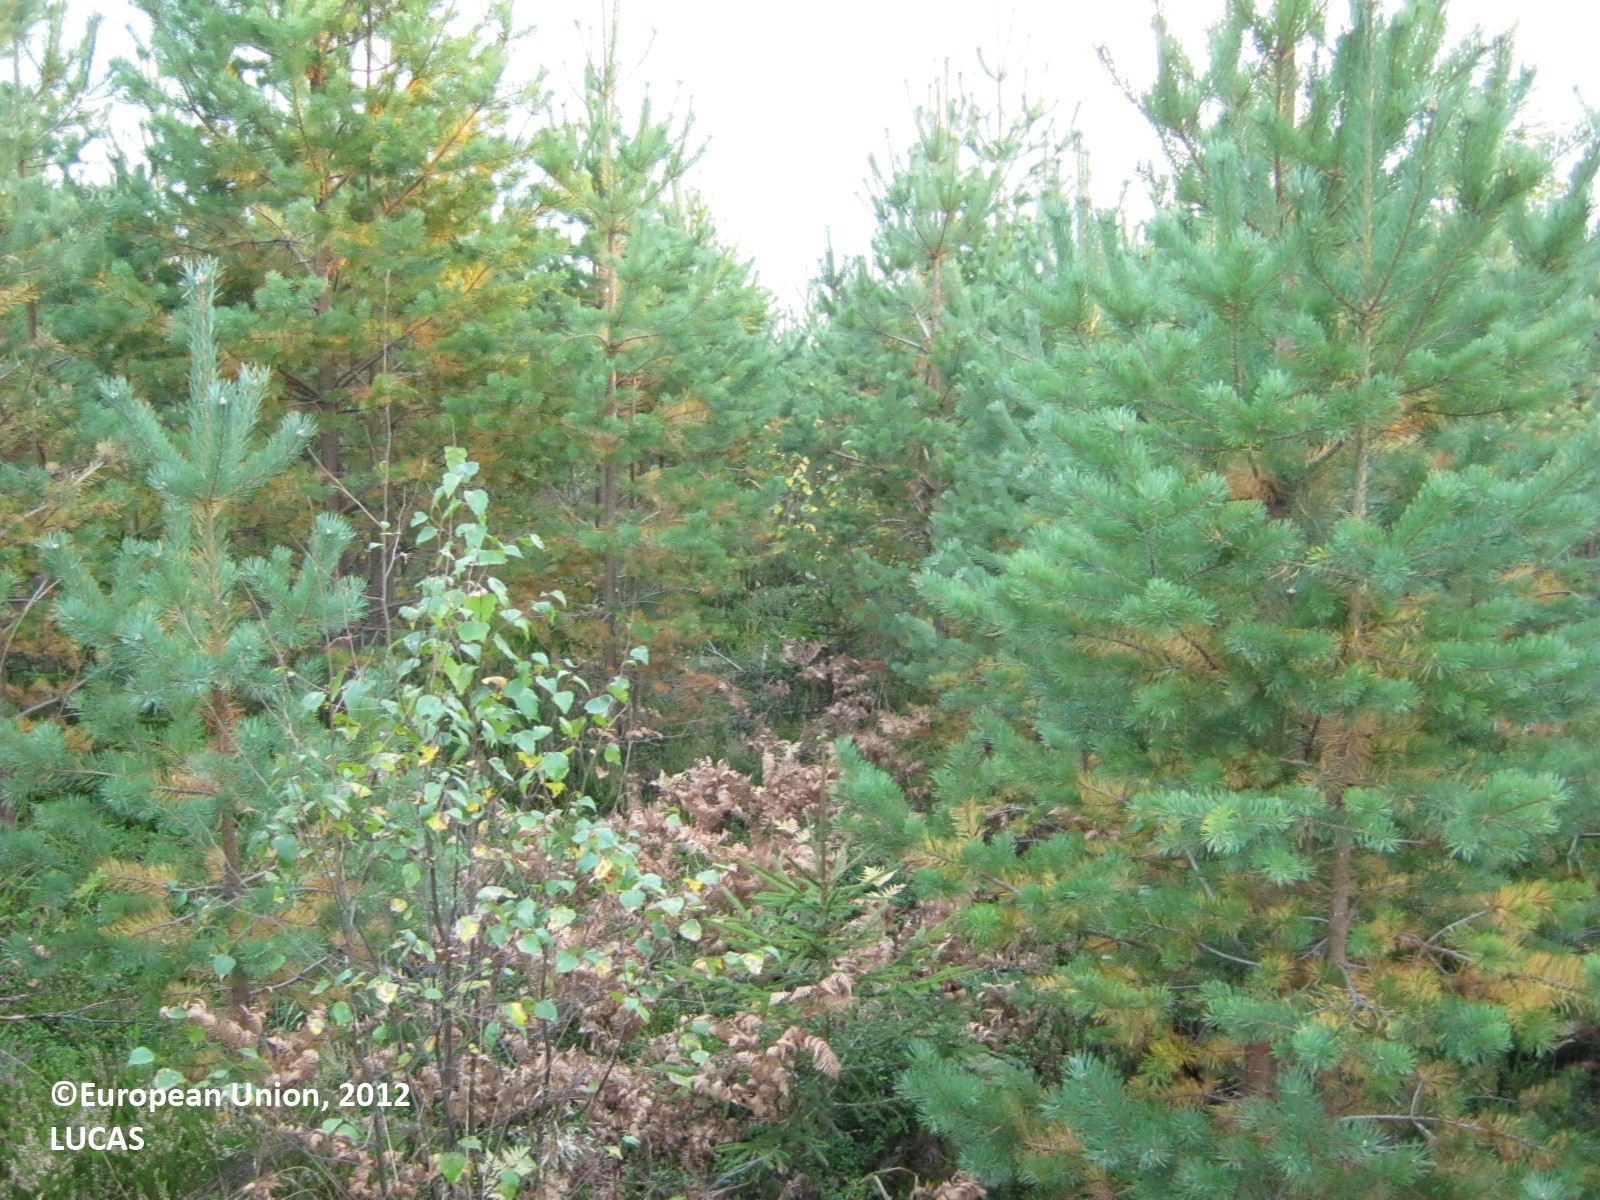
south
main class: Woodland
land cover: Pine dominated coniferous woodland
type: boreal forest
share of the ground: > 75 %
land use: Forestry
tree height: < 5 m
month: September
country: FI
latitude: 60.8488
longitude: 27.9583
